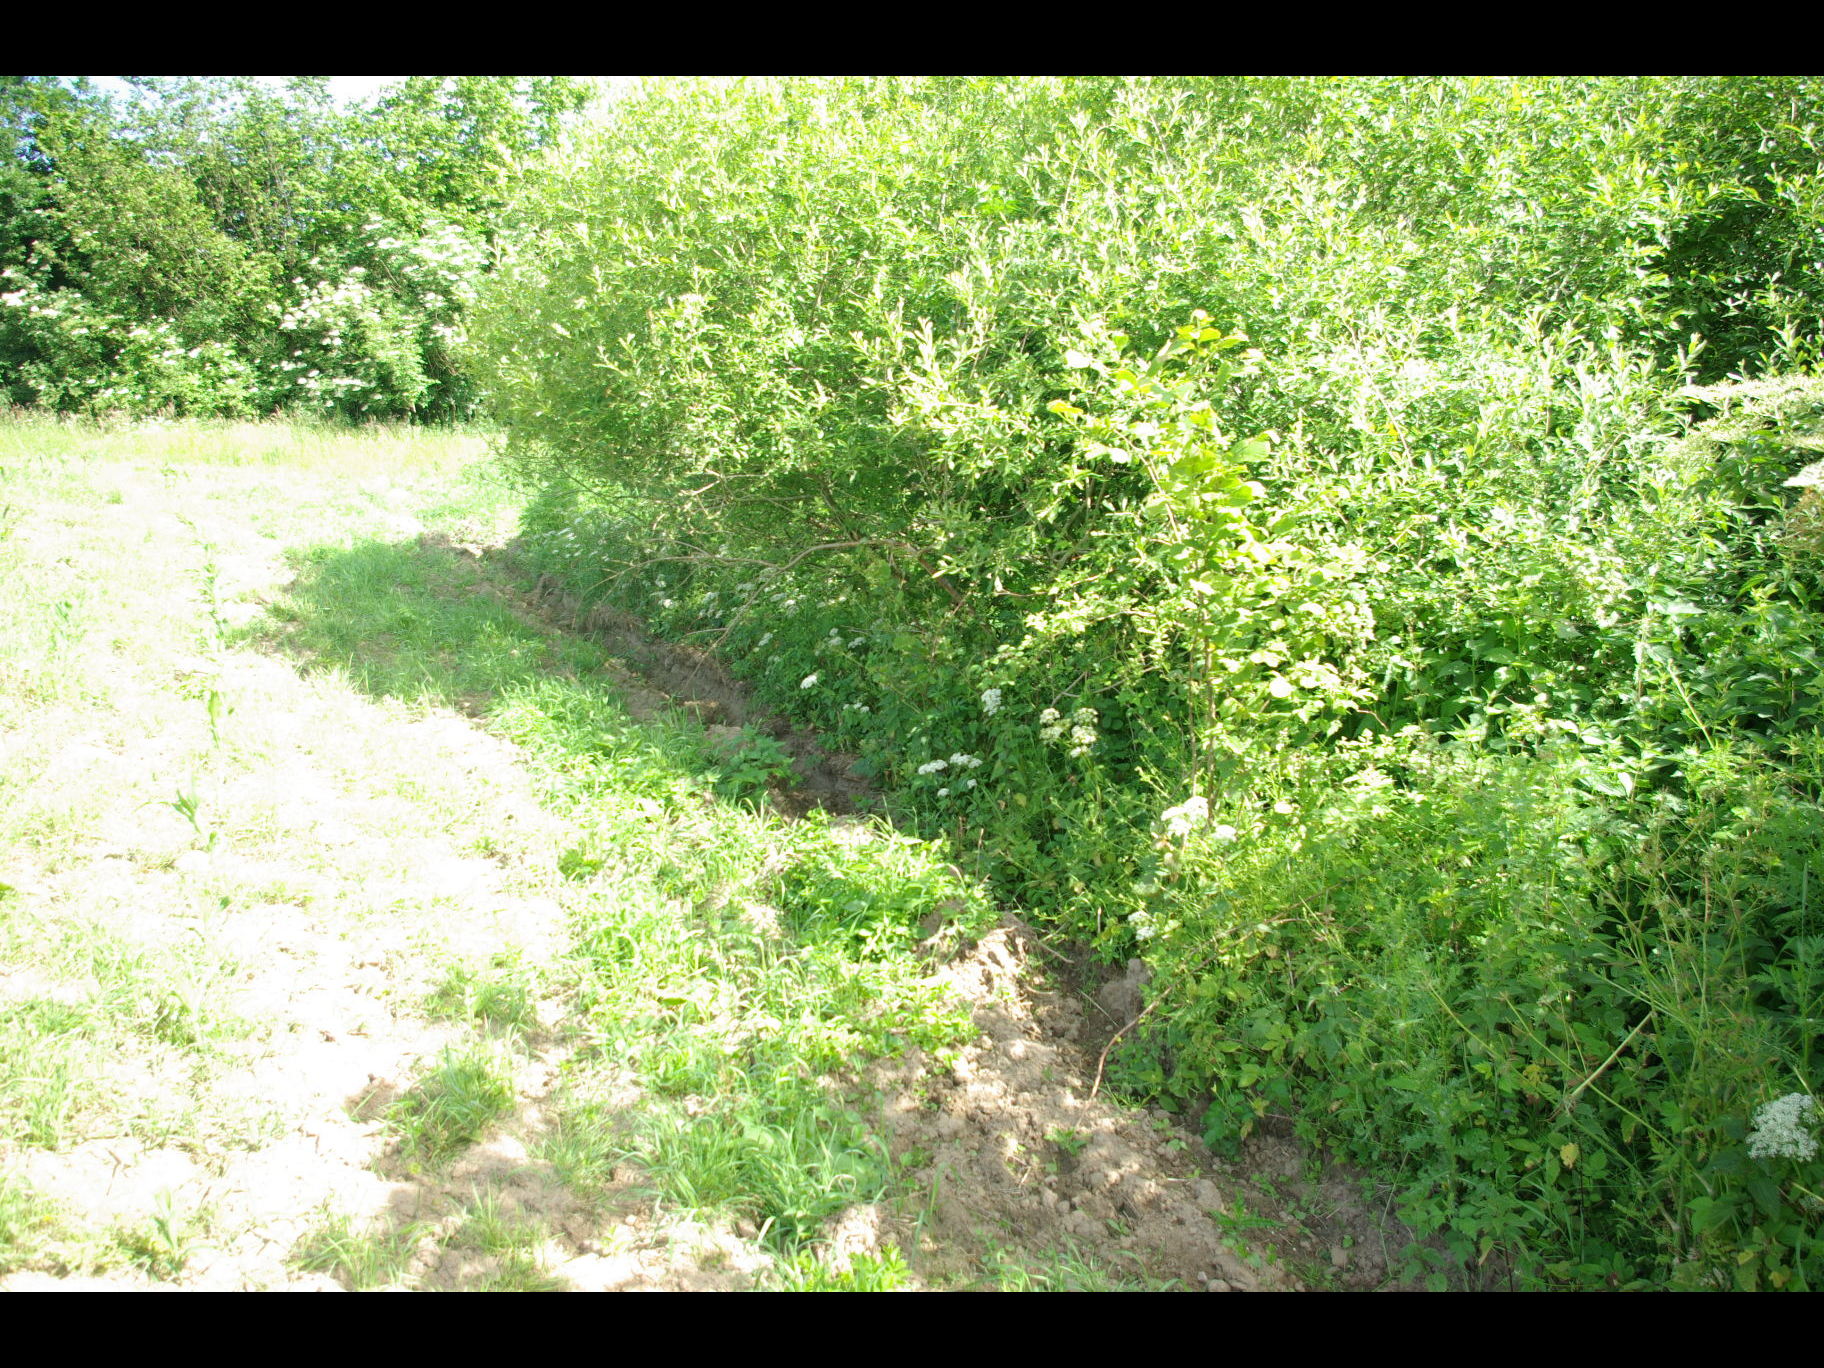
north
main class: Cropland
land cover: Maize
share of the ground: 10 - 25 %
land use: Agriculture (excluding fallow land and kitchen gardens)
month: June
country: DE
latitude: 54.2466
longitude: 9.8926
